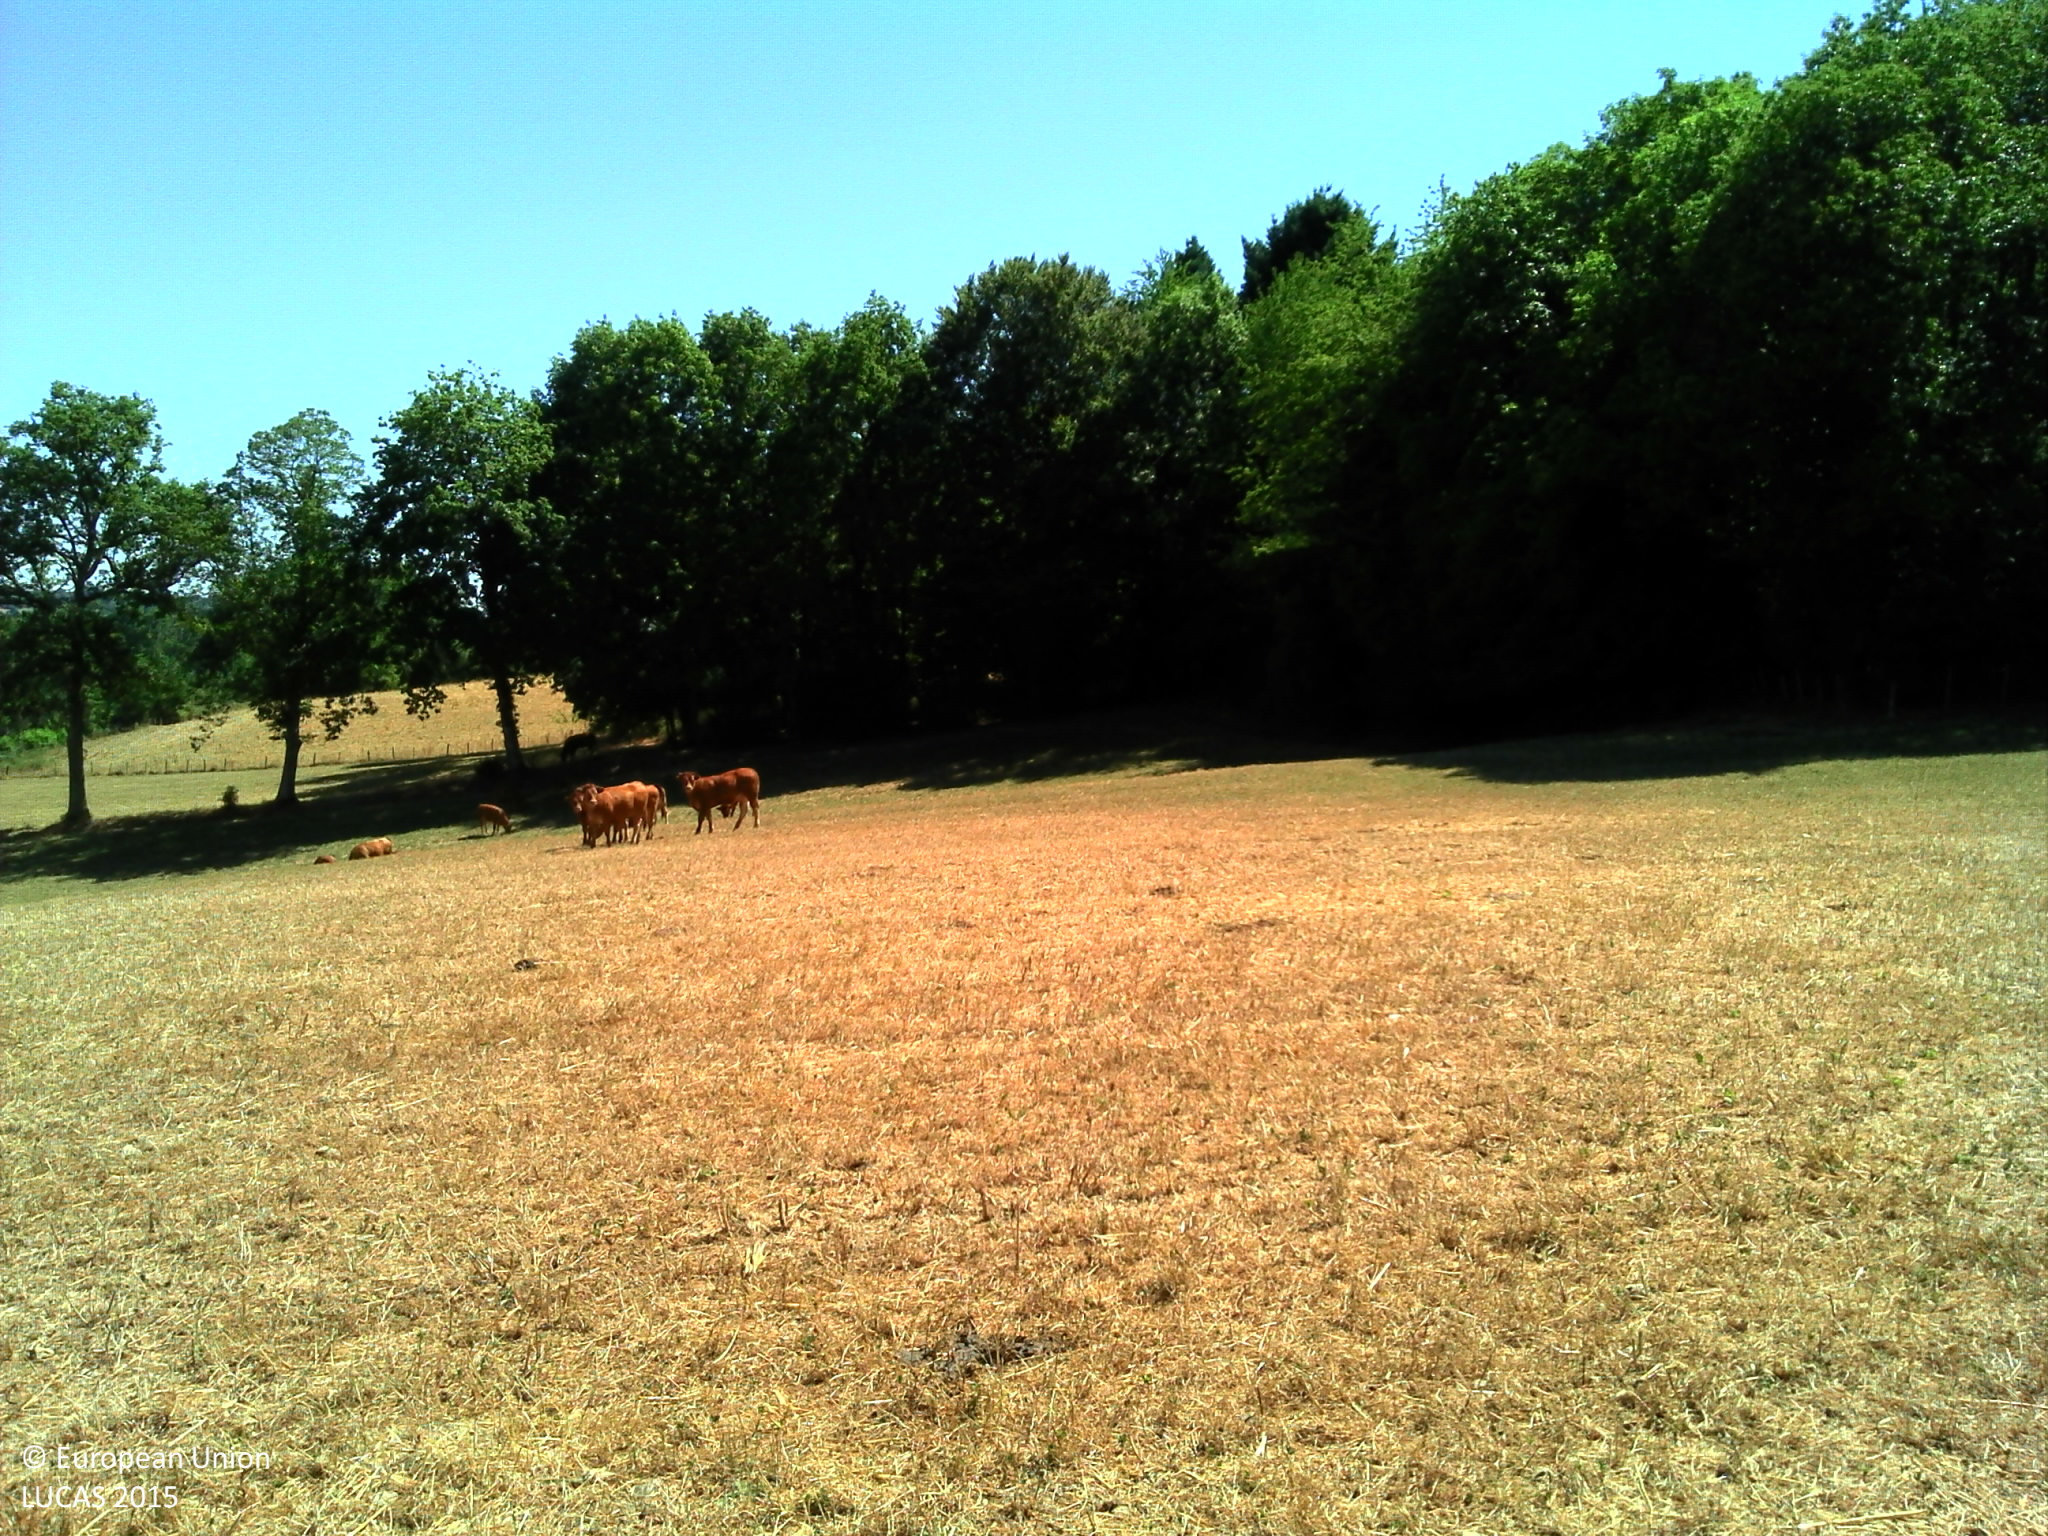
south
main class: Grassland
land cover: Grassland without tree/shrub cover
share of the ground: > 75 %
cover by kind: herbaceous plants 95 %
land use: Agriculture (excluding fallow land and kitchen gardens)
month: July
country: FR
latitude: 45.7722
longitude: 1.4404
